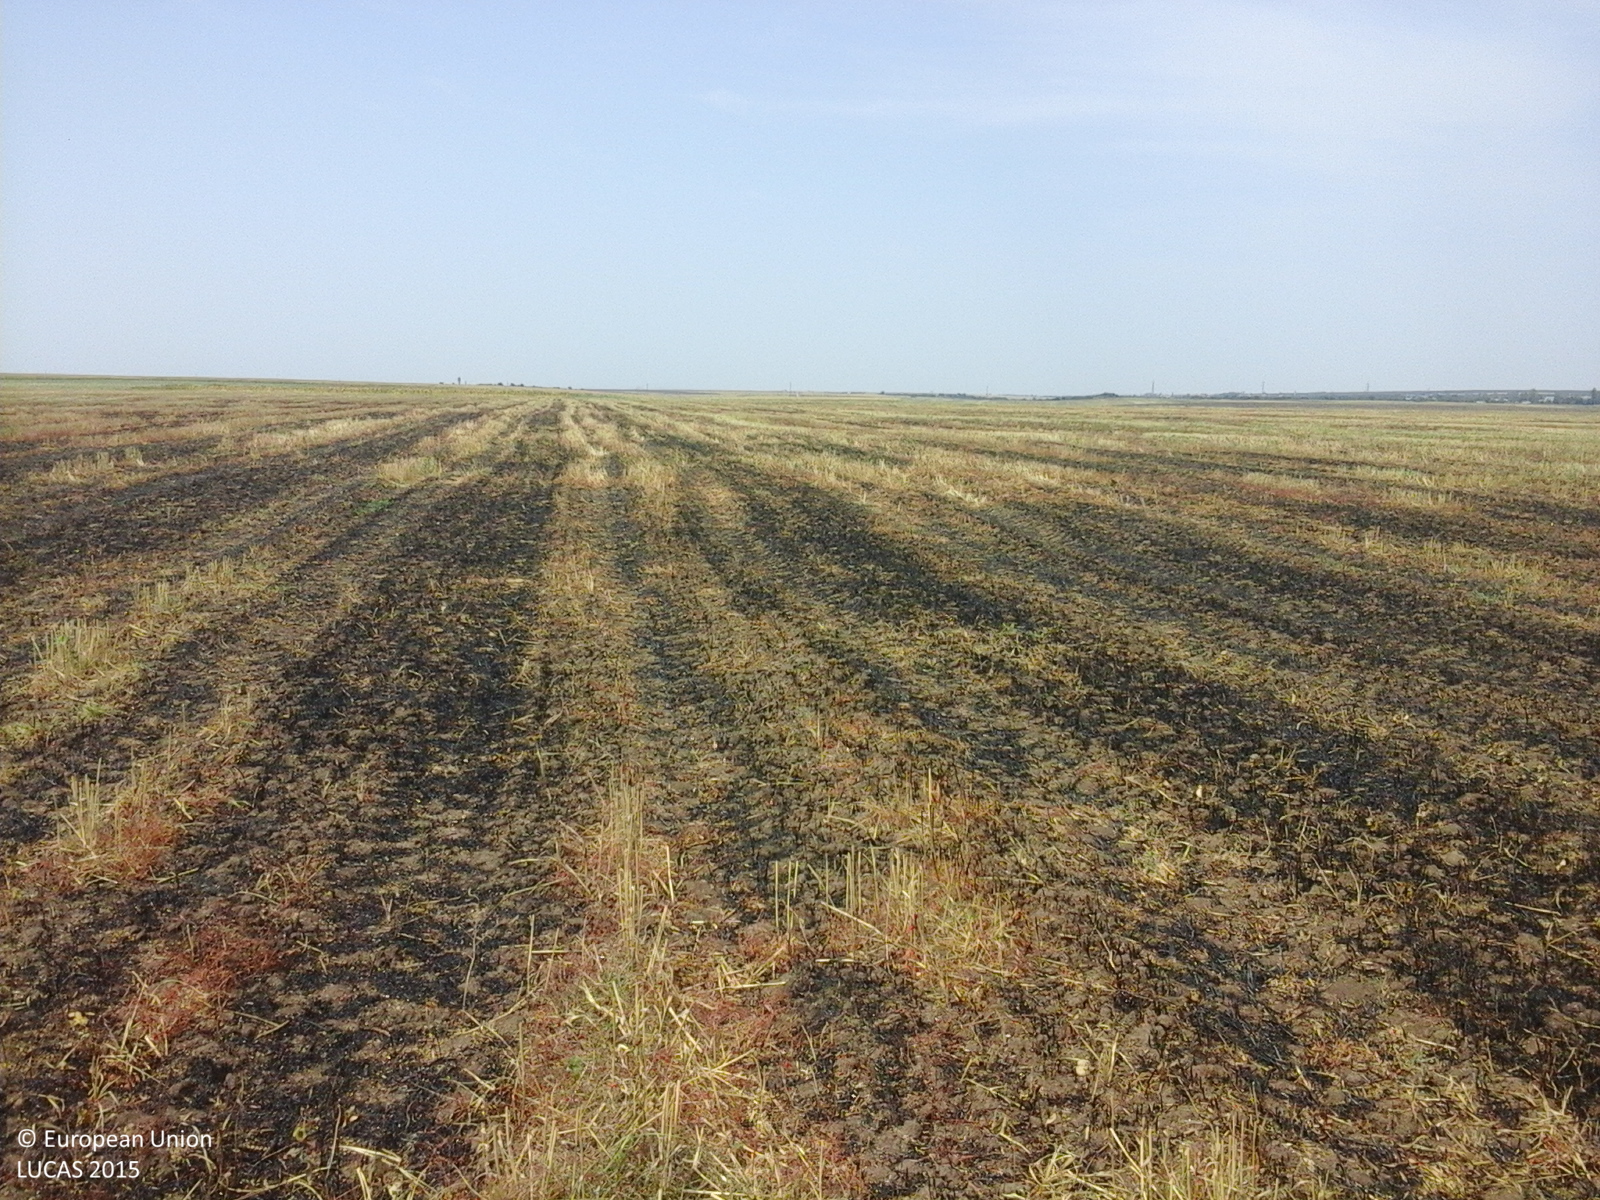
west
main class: Cropland
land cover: Common wheat
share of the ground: 25 - 50 %
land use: Agriculture (excluding fallow land and kitchen gardens)
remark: Burnt area
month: August
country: RO
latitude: 44.1941
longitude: 23.2212
